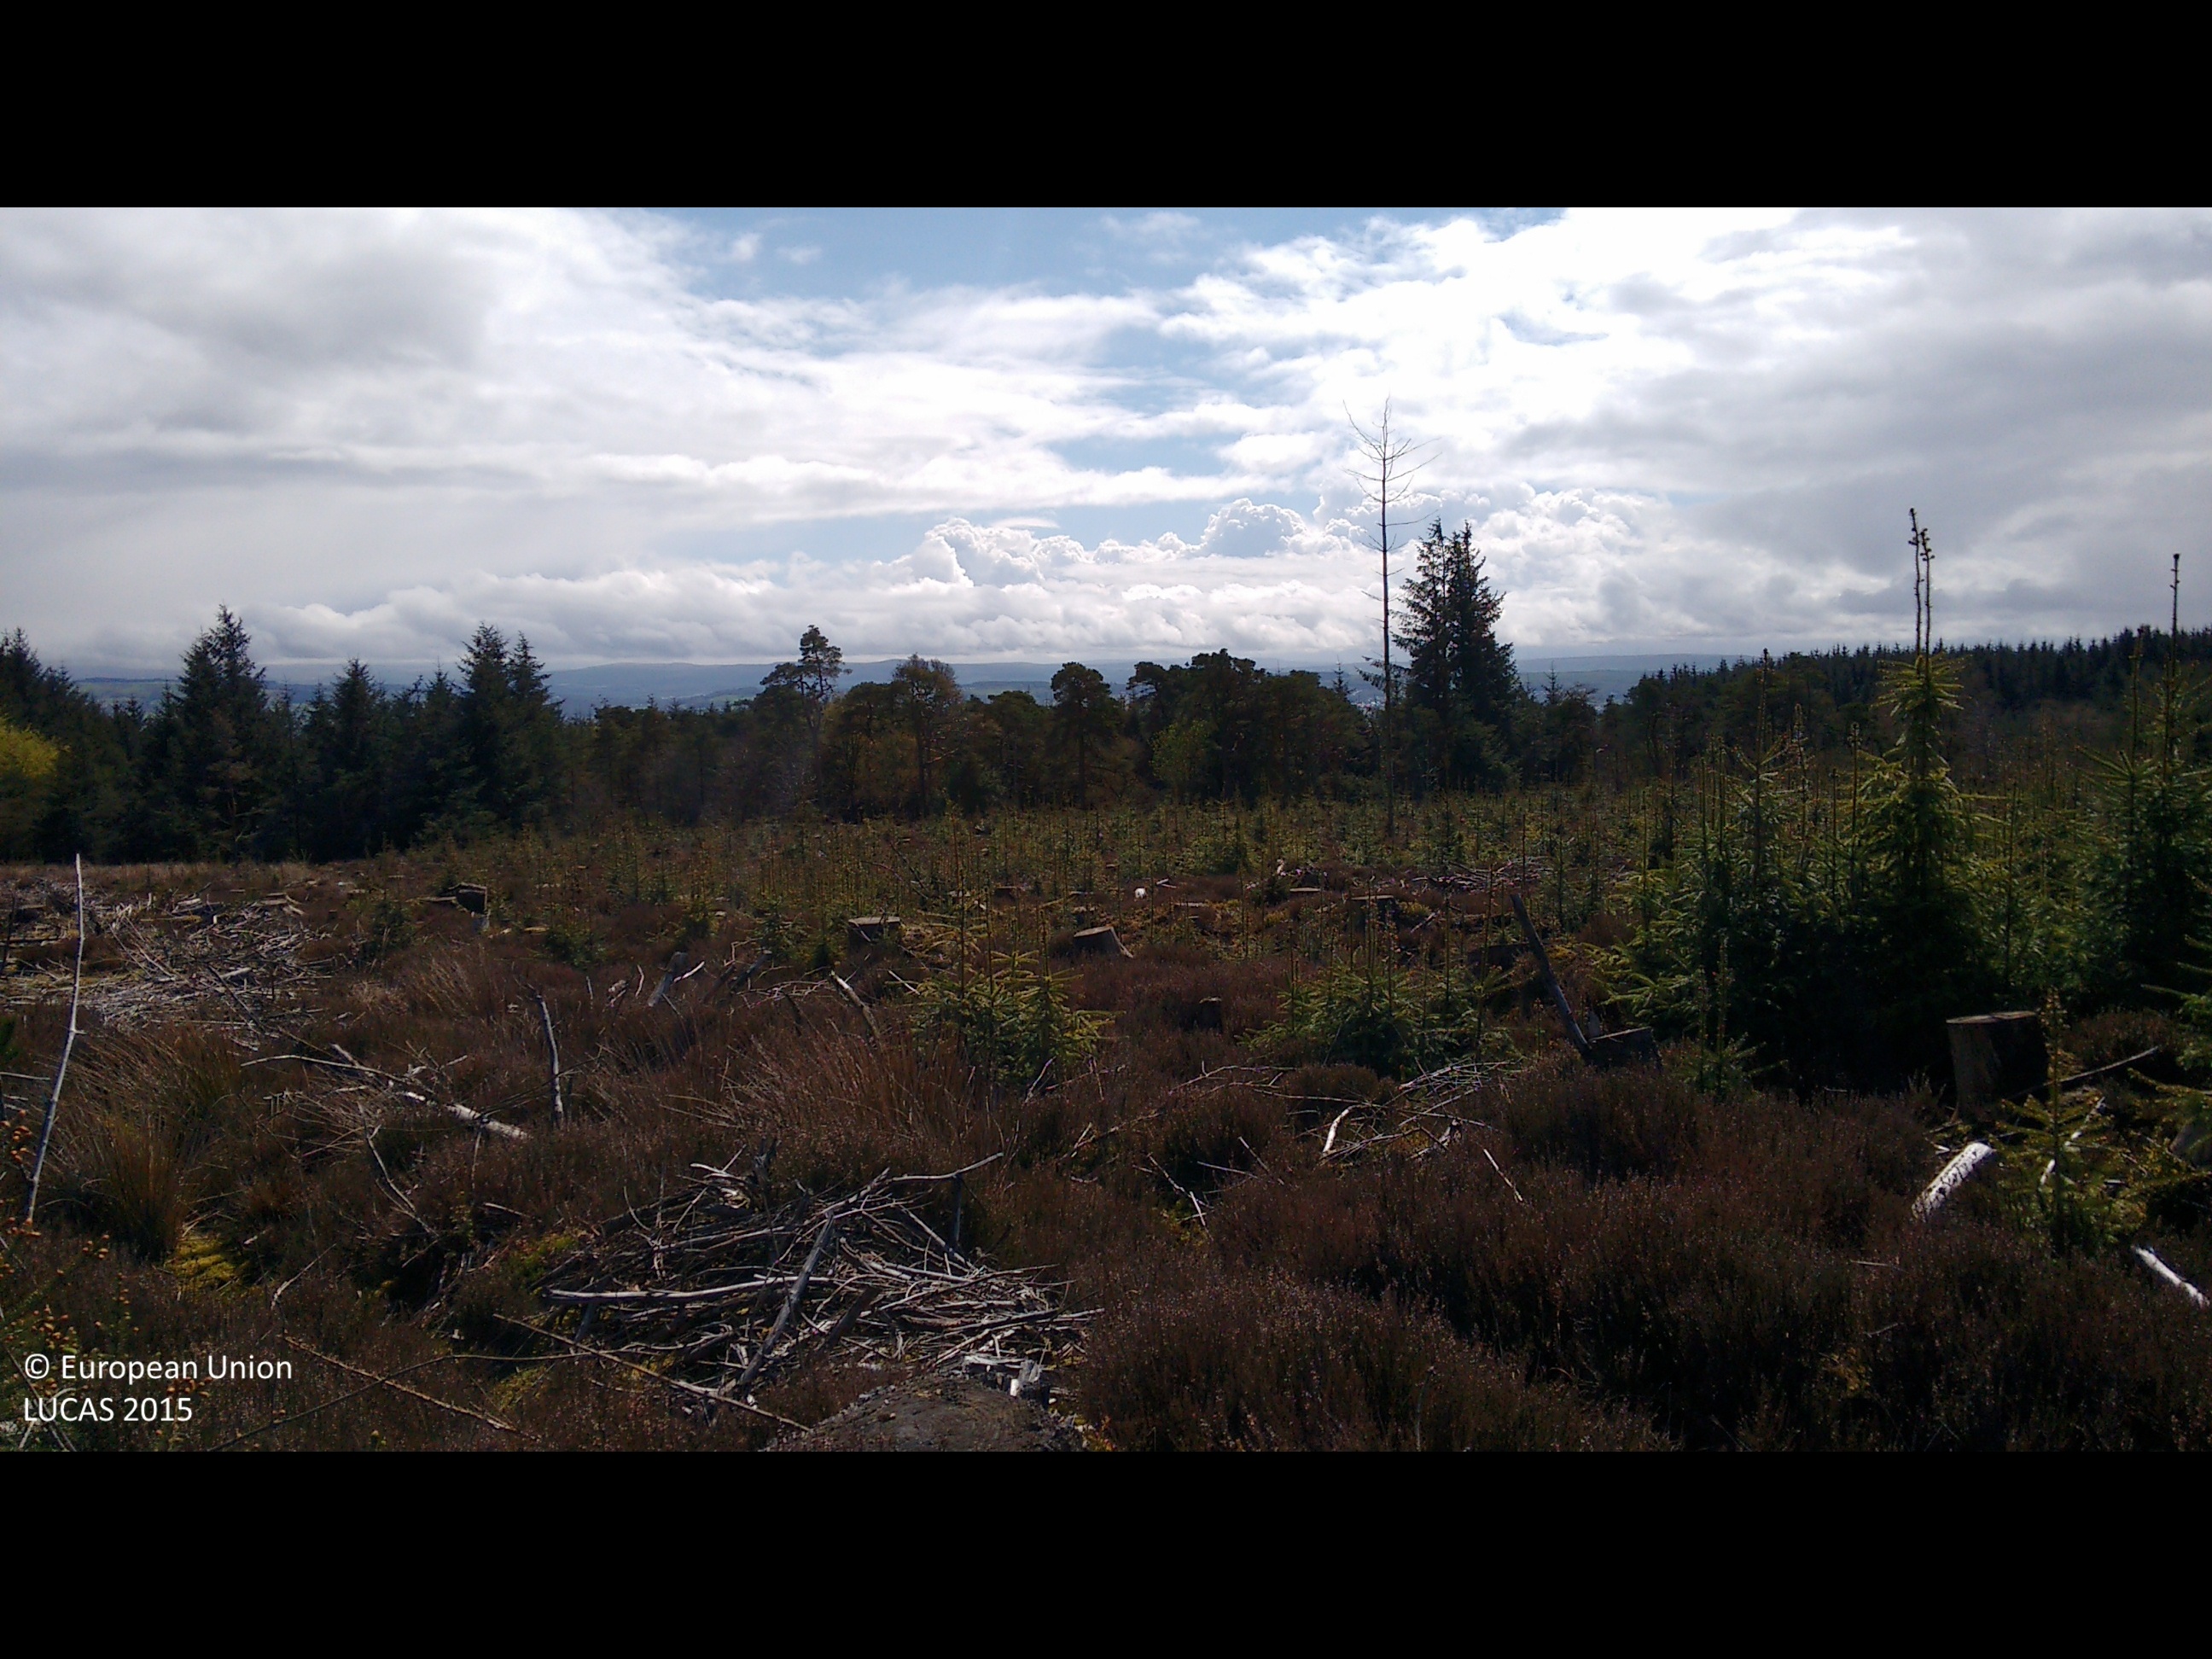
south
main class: Woodland
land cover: Spruce dominated coniferous woodland
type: exotic forest
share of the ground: 25 - 50 %
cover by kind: coniferous forest trees 50 %, herbaceous plants 35 %, shrubs 15 %
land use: Forestry
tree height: < 5 m
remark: Clear cut
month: April
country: GB
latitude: 53.8597
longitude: -2.5178
